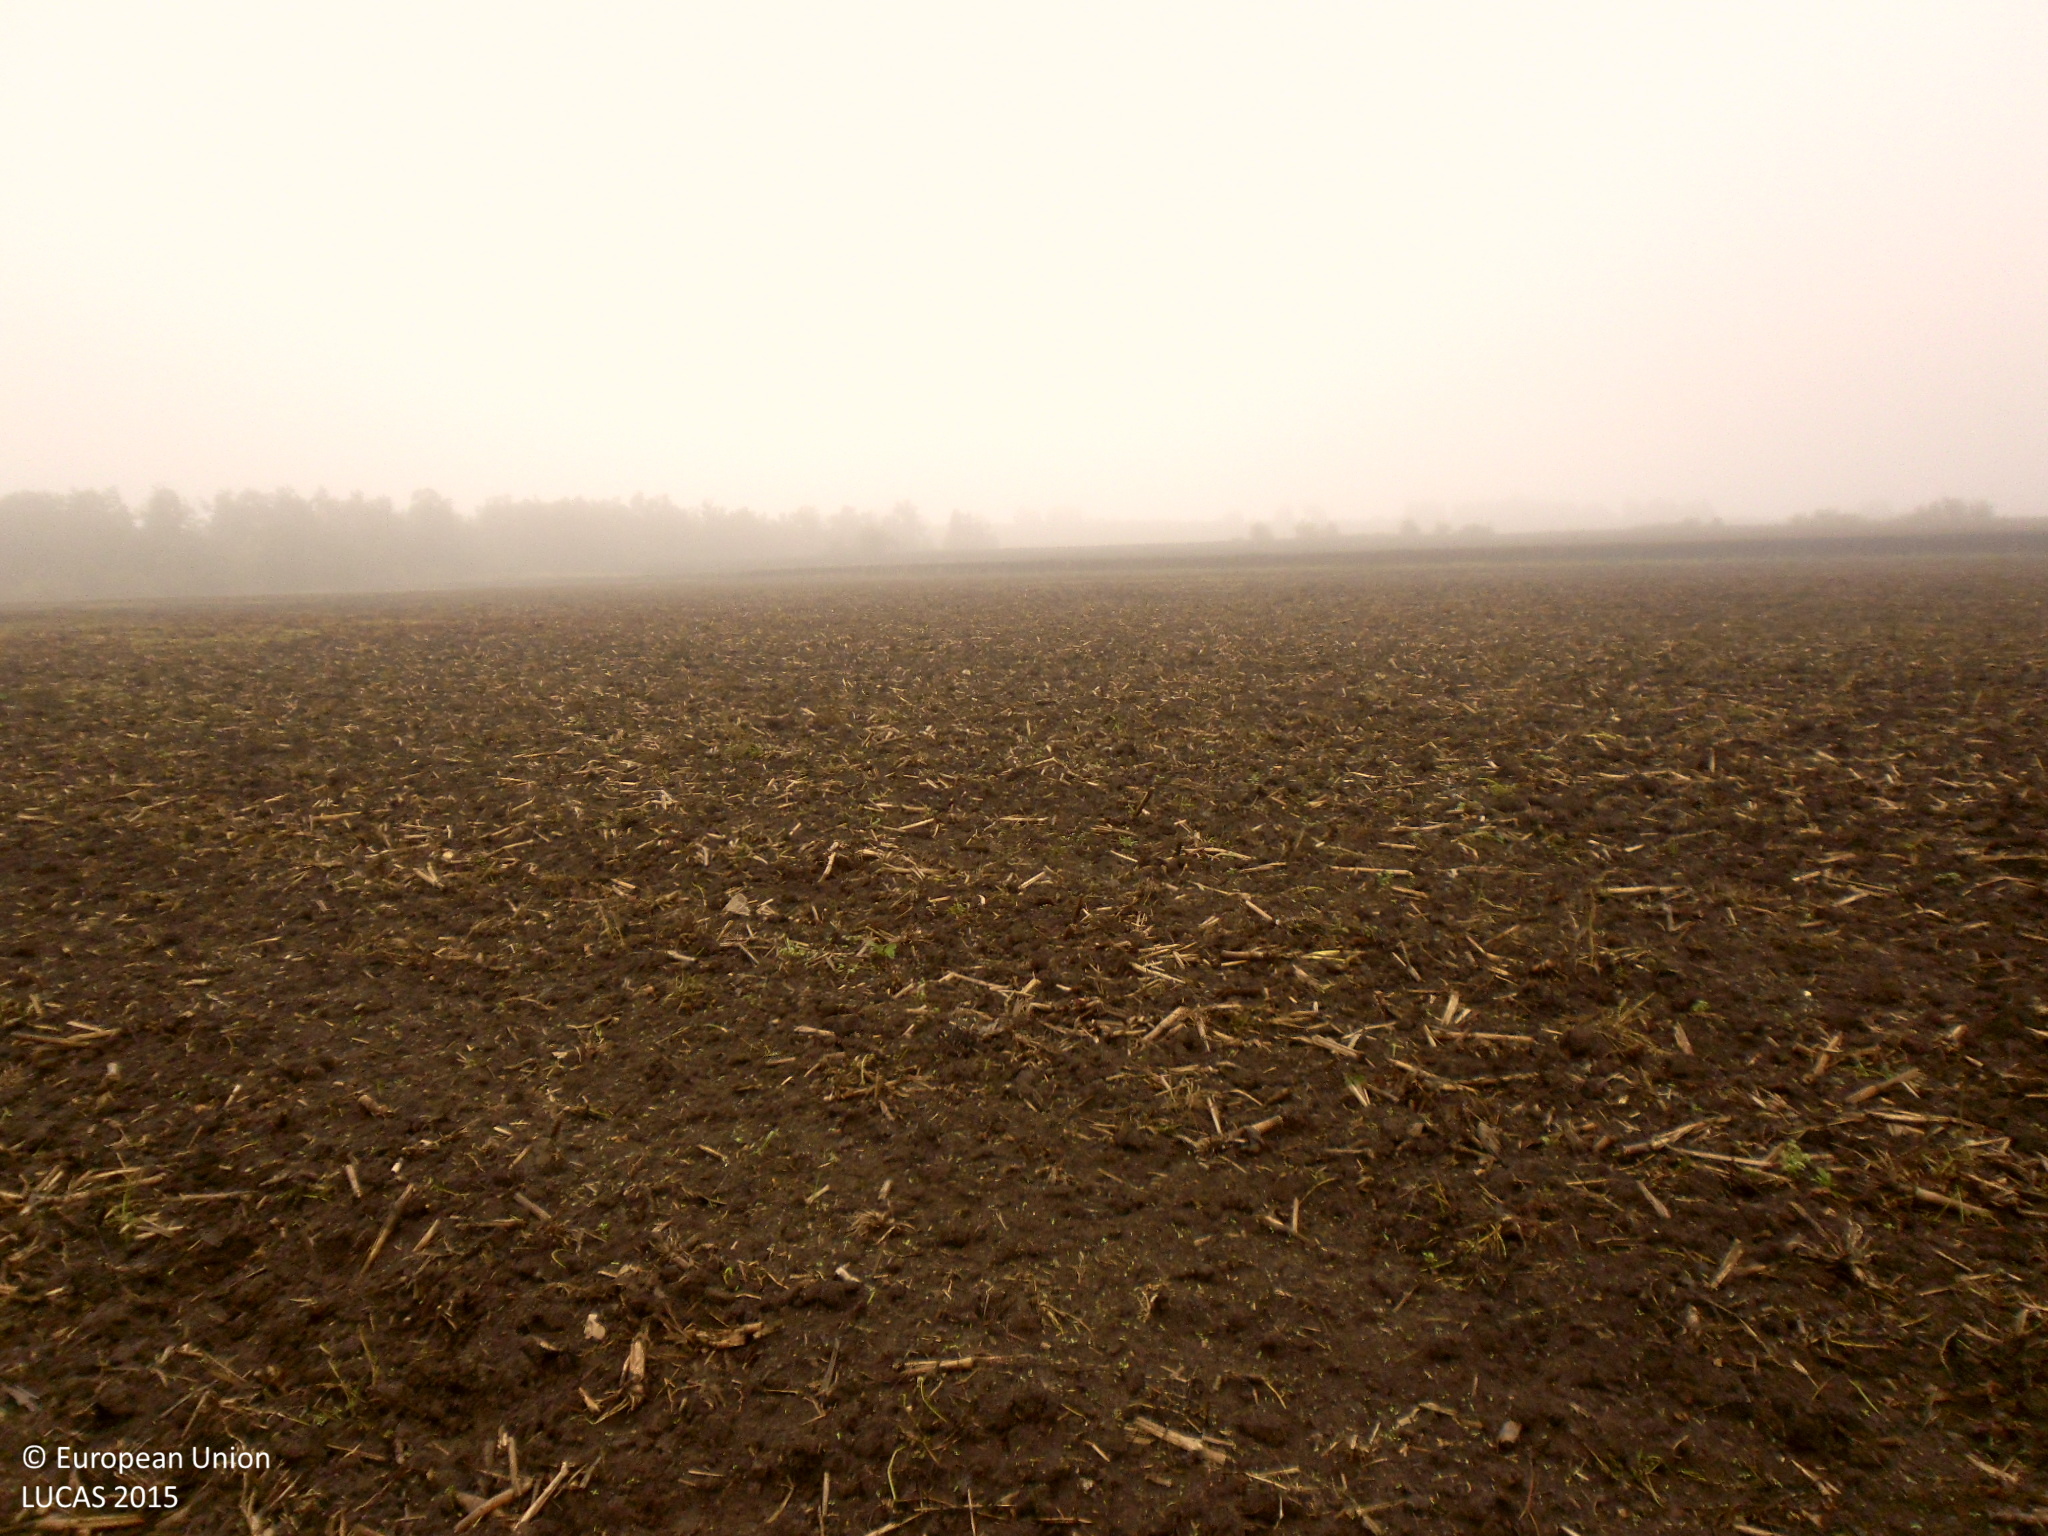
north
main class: Cropland
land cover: Maize
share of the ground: < 10 %
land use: Agriculture (excluding fallow land and kitchen gardens)
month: October
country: BG
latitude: 43.9284
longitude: 22.5780
